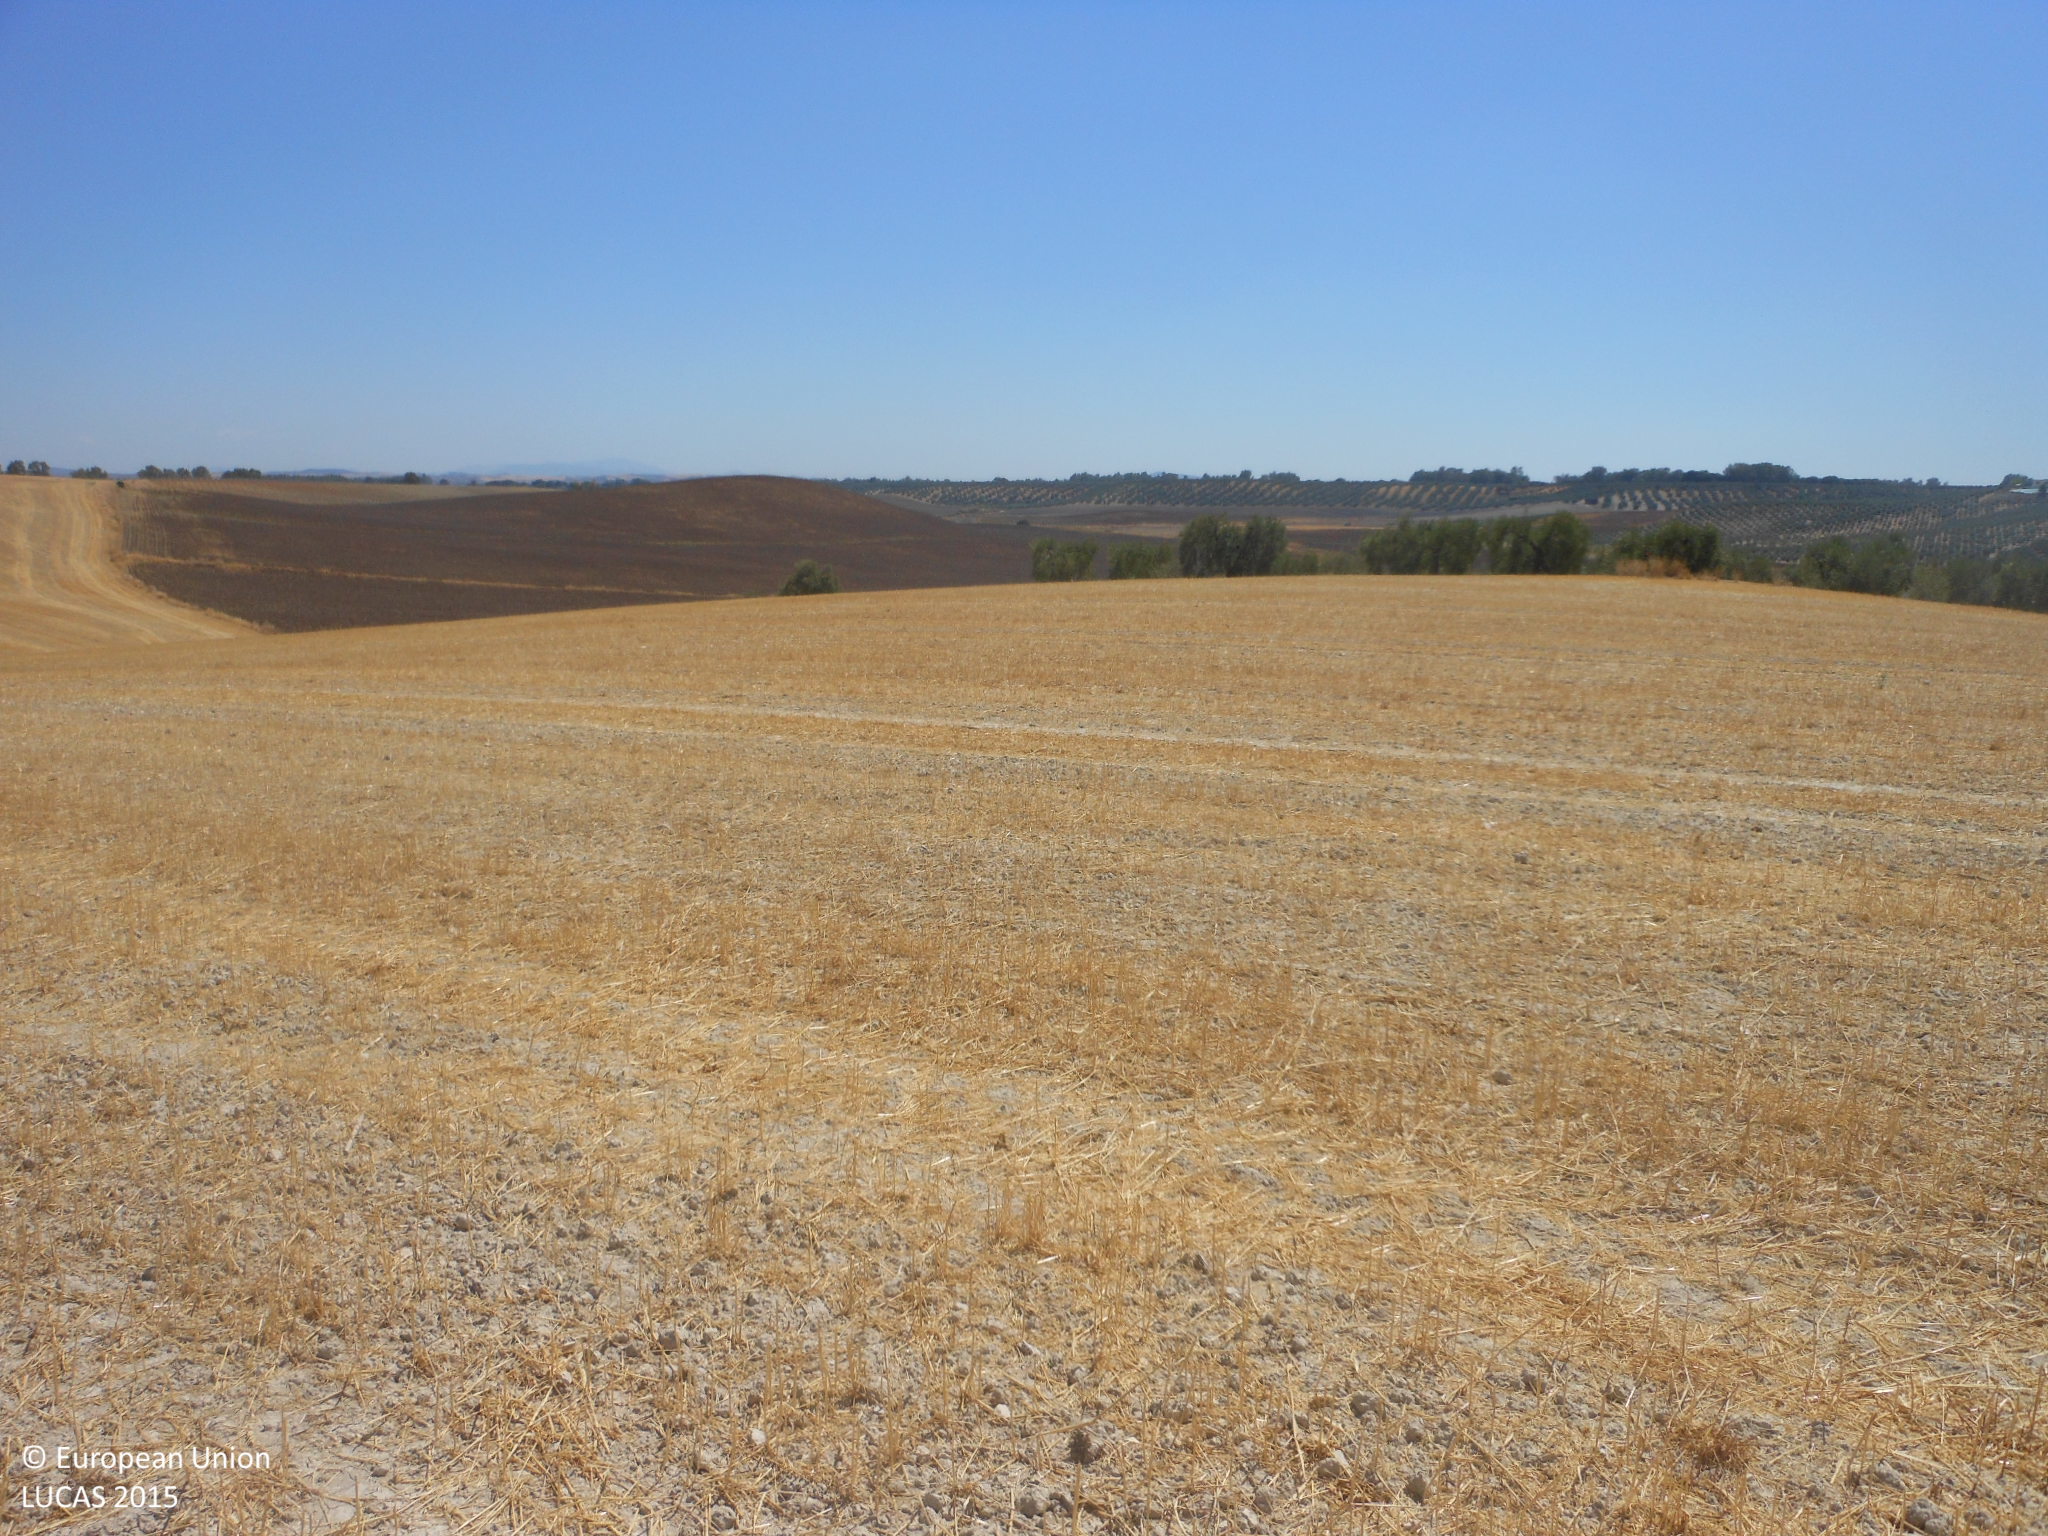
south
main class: Cropland
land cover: Common wheat
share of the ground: < 10 %
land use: Agriculture (excluding fallow land and kitchen gardens)
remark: Harvested field
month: July
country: ES
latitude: 37.3008
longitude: -5.3667
